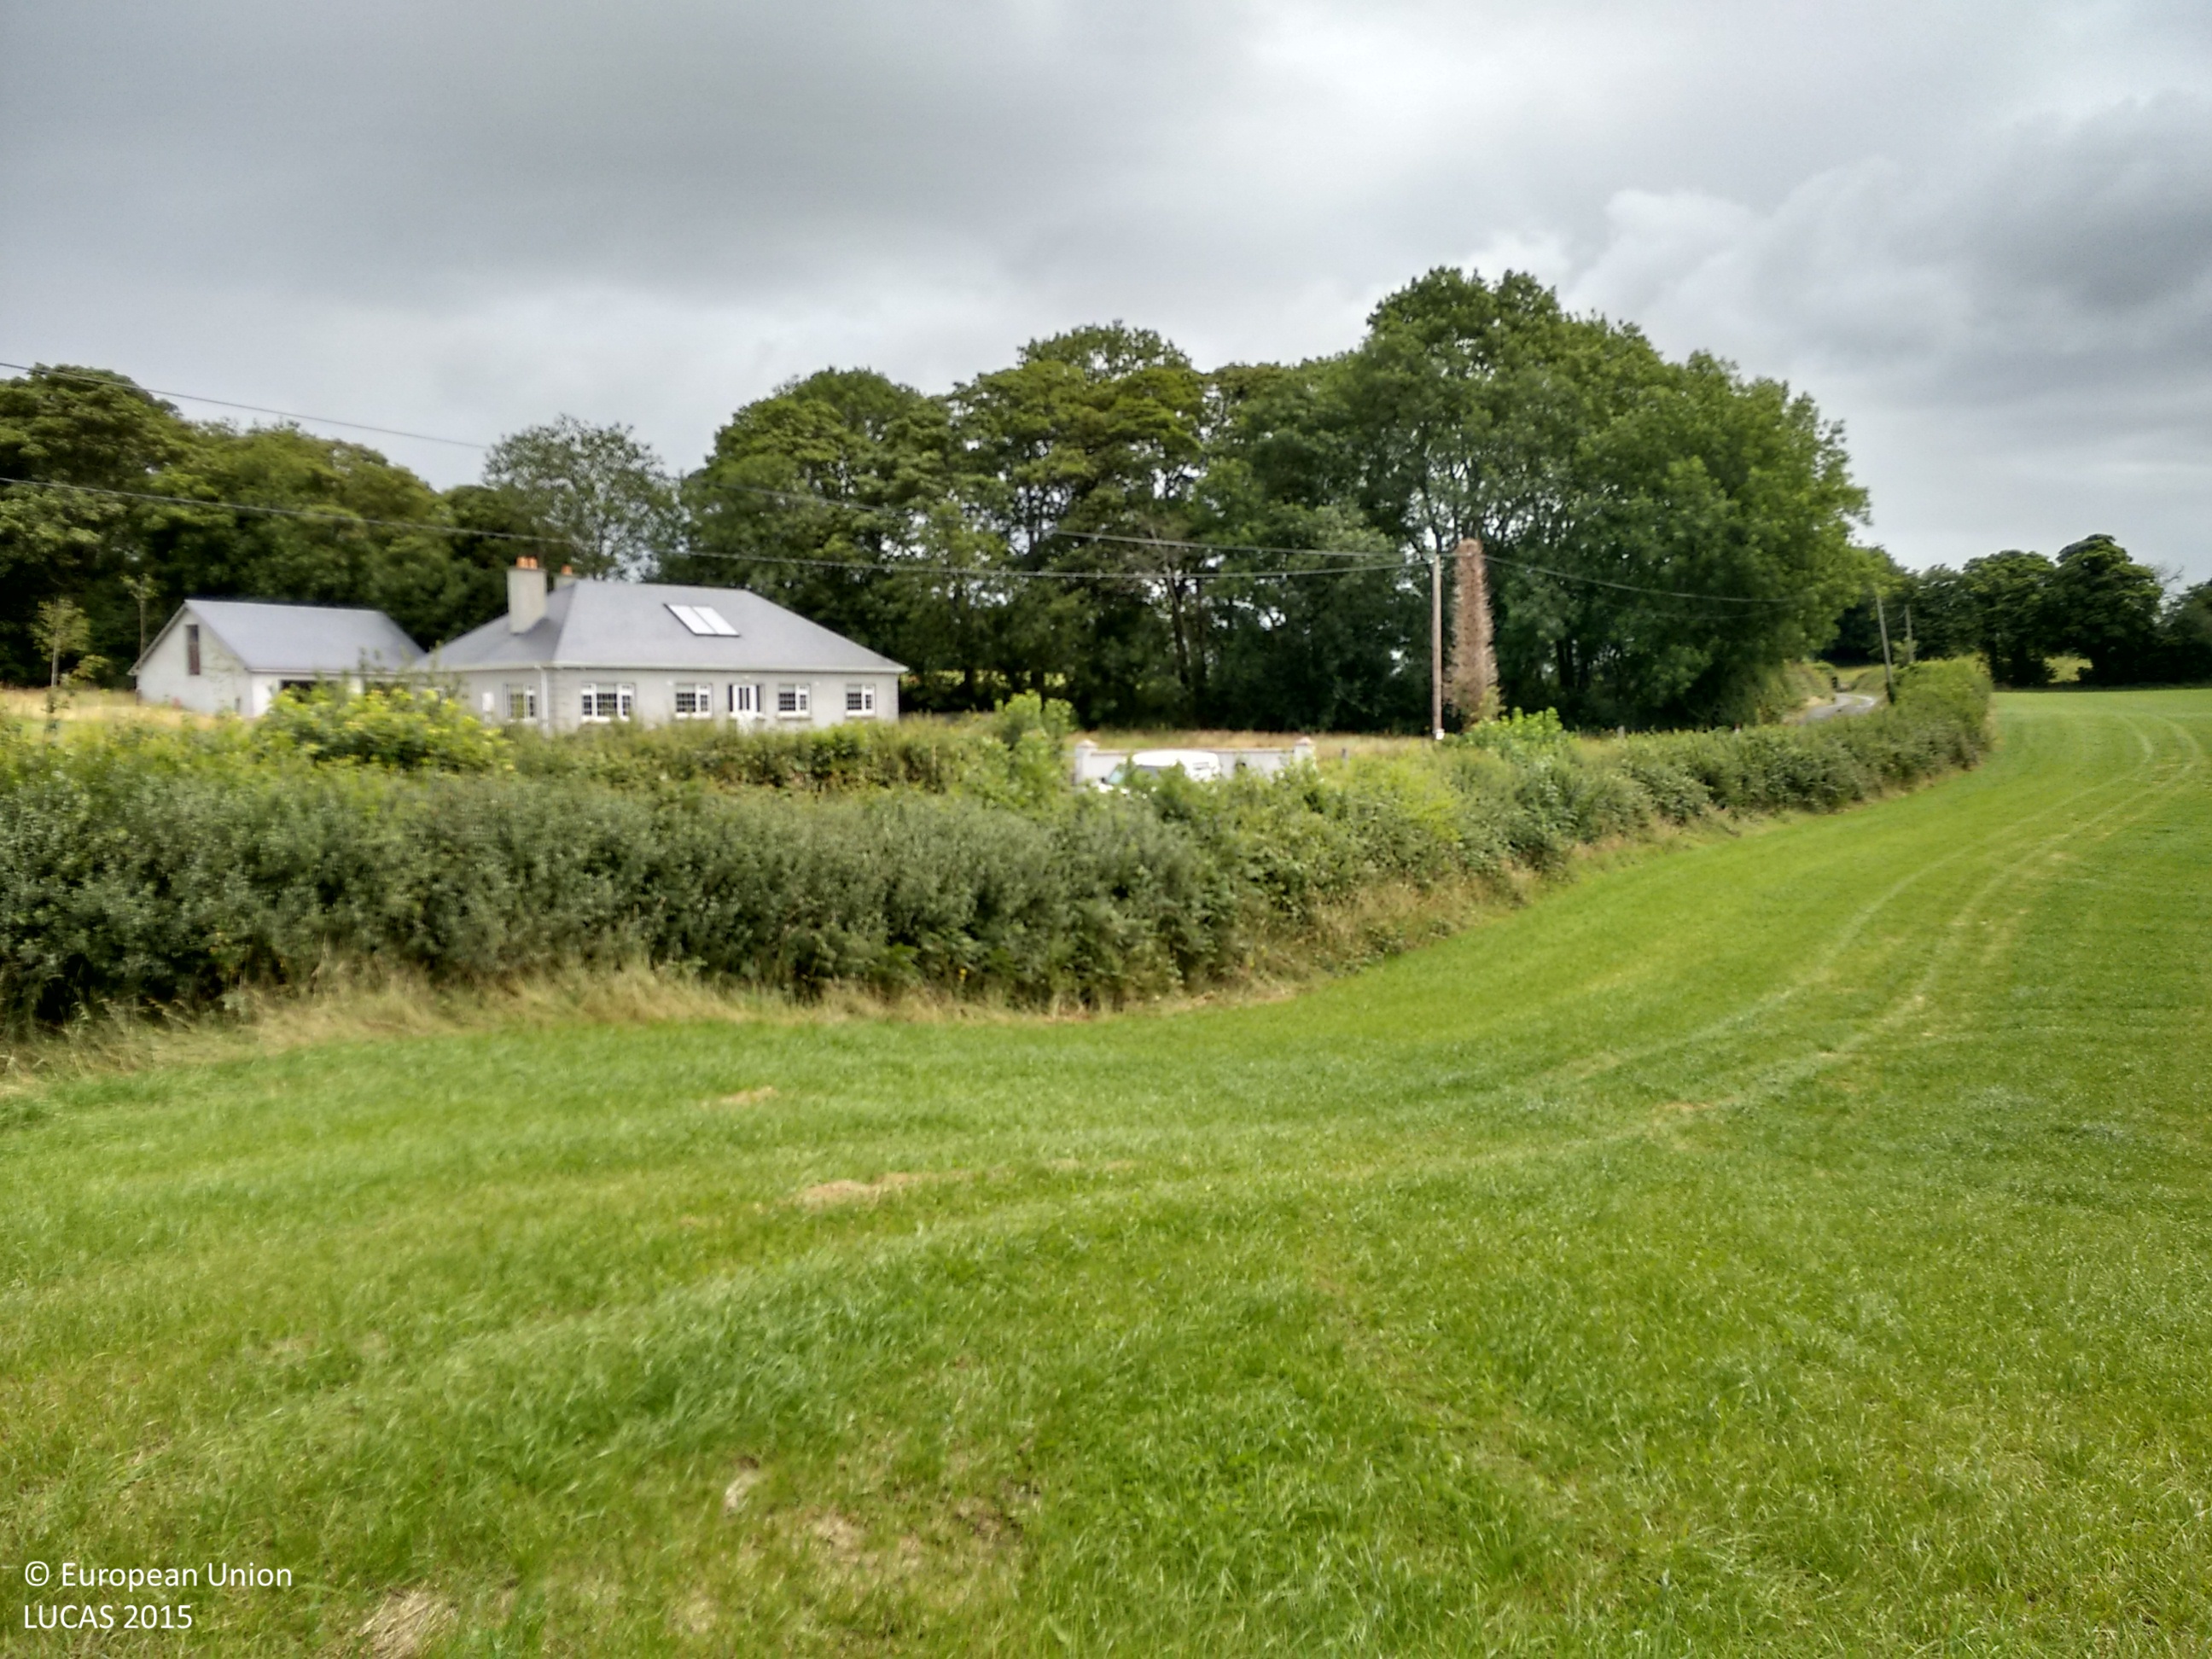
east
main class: Grassland
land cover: Grassland without tree/shrub cover
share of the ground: > 75 %
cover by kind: herbaceous plants 100 %
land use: Agriculture (excluding fallow land and kitchen gardens)
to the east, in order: Grassland without tree/shrub cover; Abandoned hedges; Electric lines; Artificial constructions in urban areas; Broadleaved woodland; Fences; Broadleaved woodland; Grassland without tree/shrub cover
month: July
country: IE
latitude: 53.1072
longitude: -7.9961
